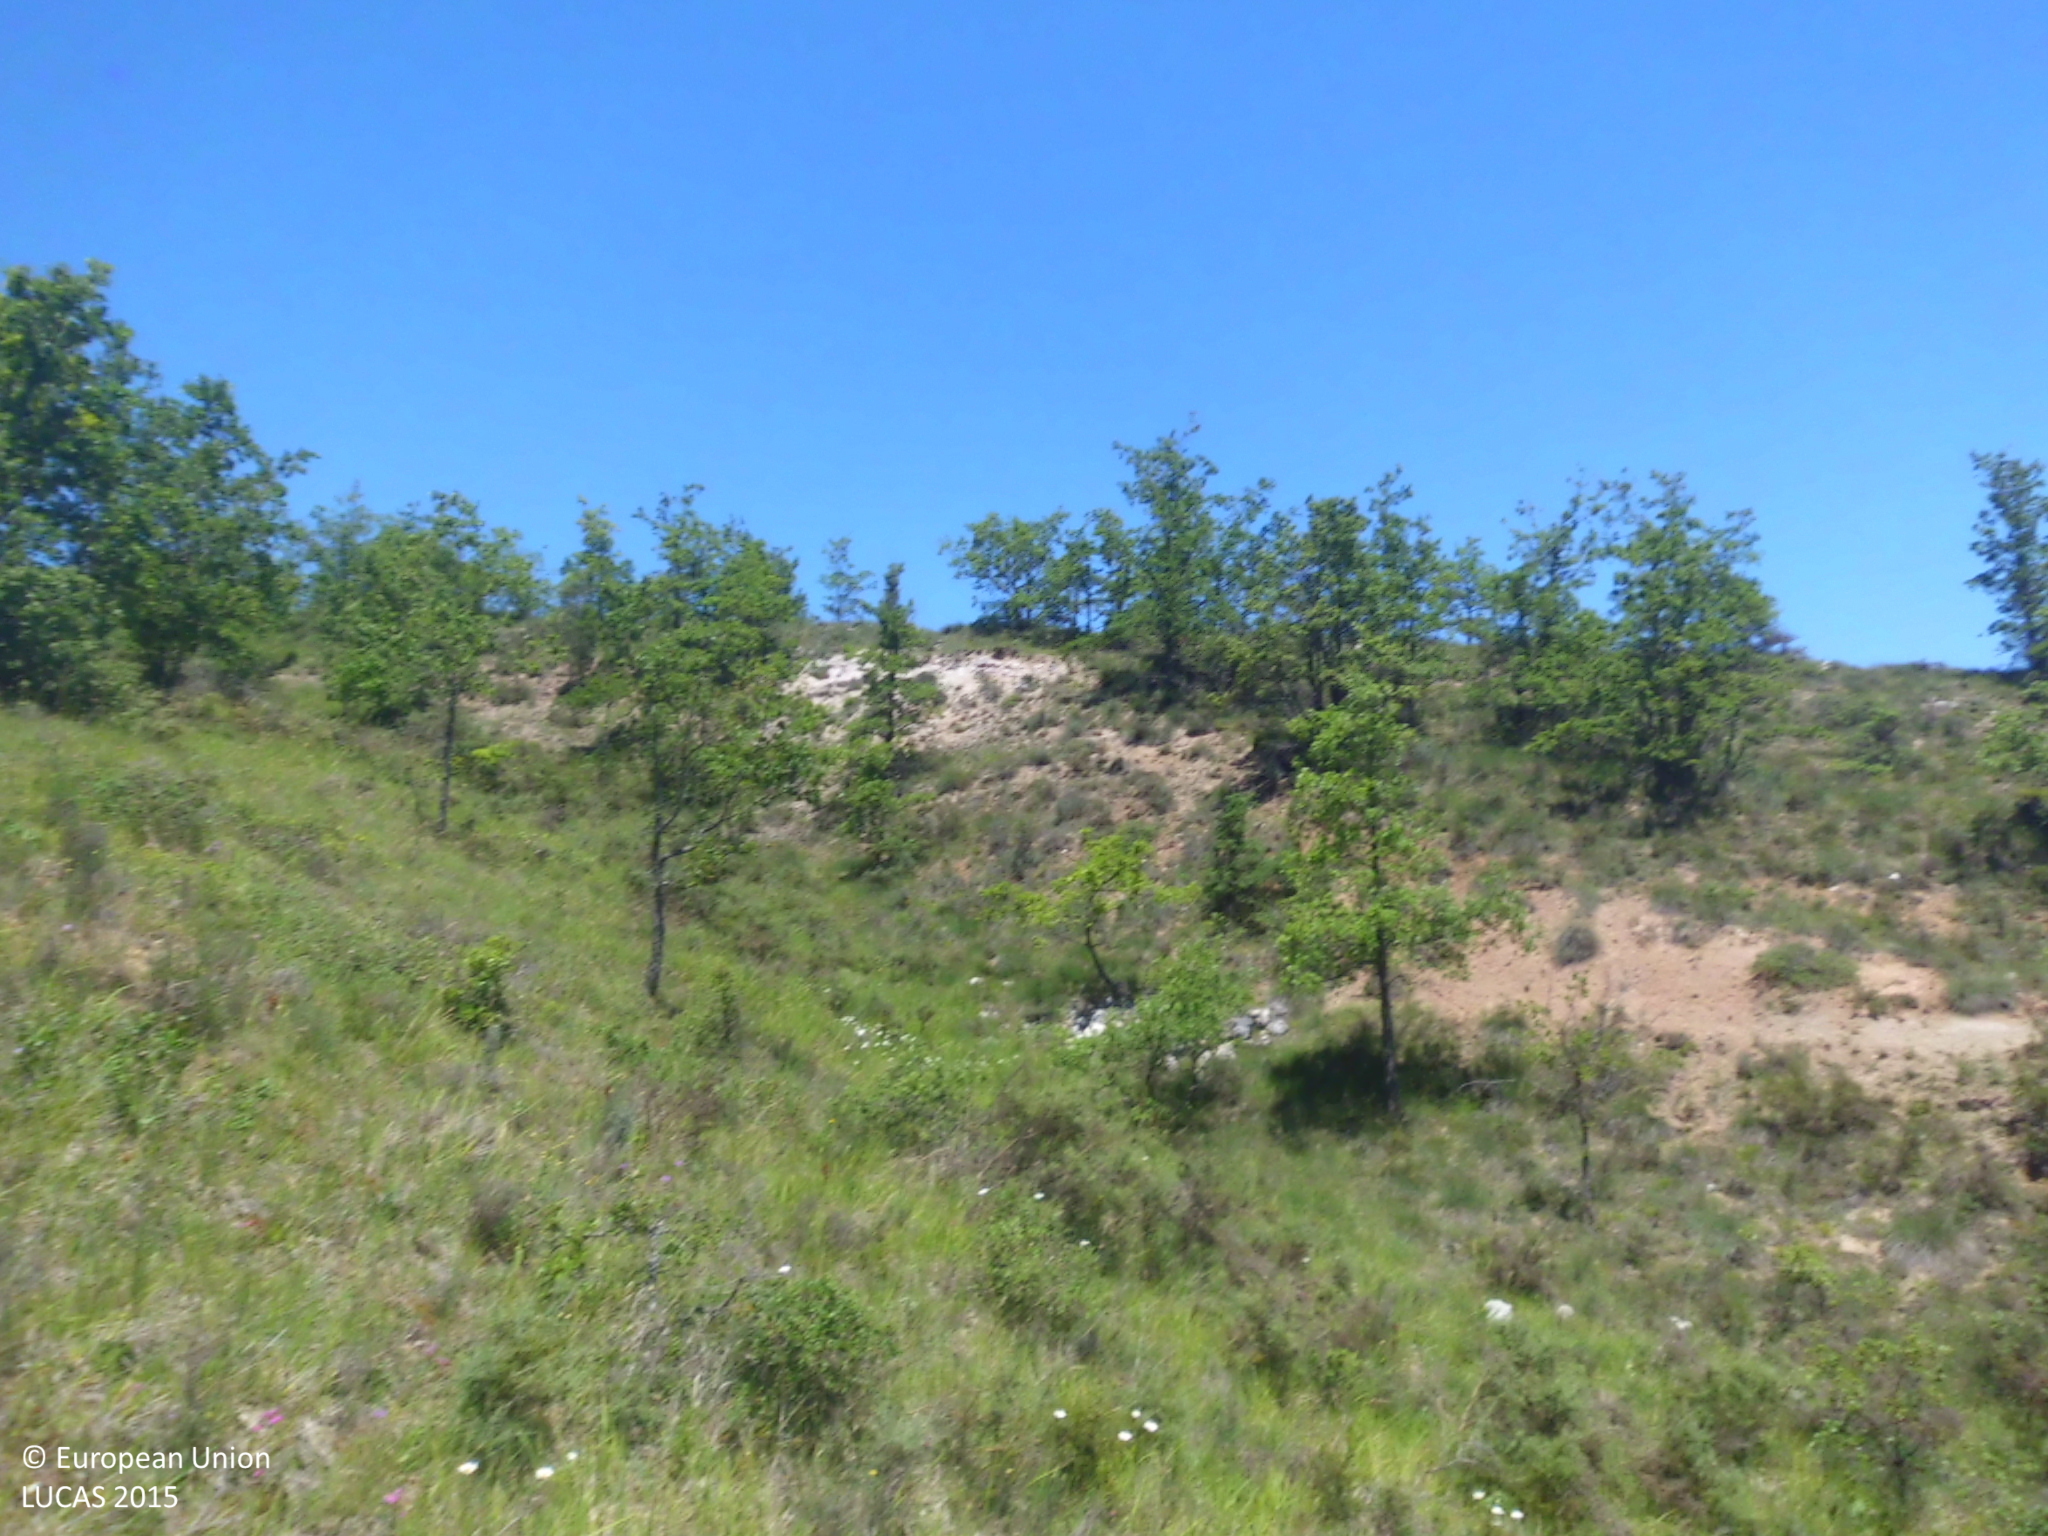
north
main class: Grassland
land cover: Grassland with sparse tree/shrub cover
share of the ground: > 75 %
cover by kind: herbaceous plants 90 %, broadleaved forest trees 5 %, shrubs 5 %
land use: Abandoned areas
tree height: < 5 m
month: June
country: ES
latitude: 42.8654
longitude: -3.4654
